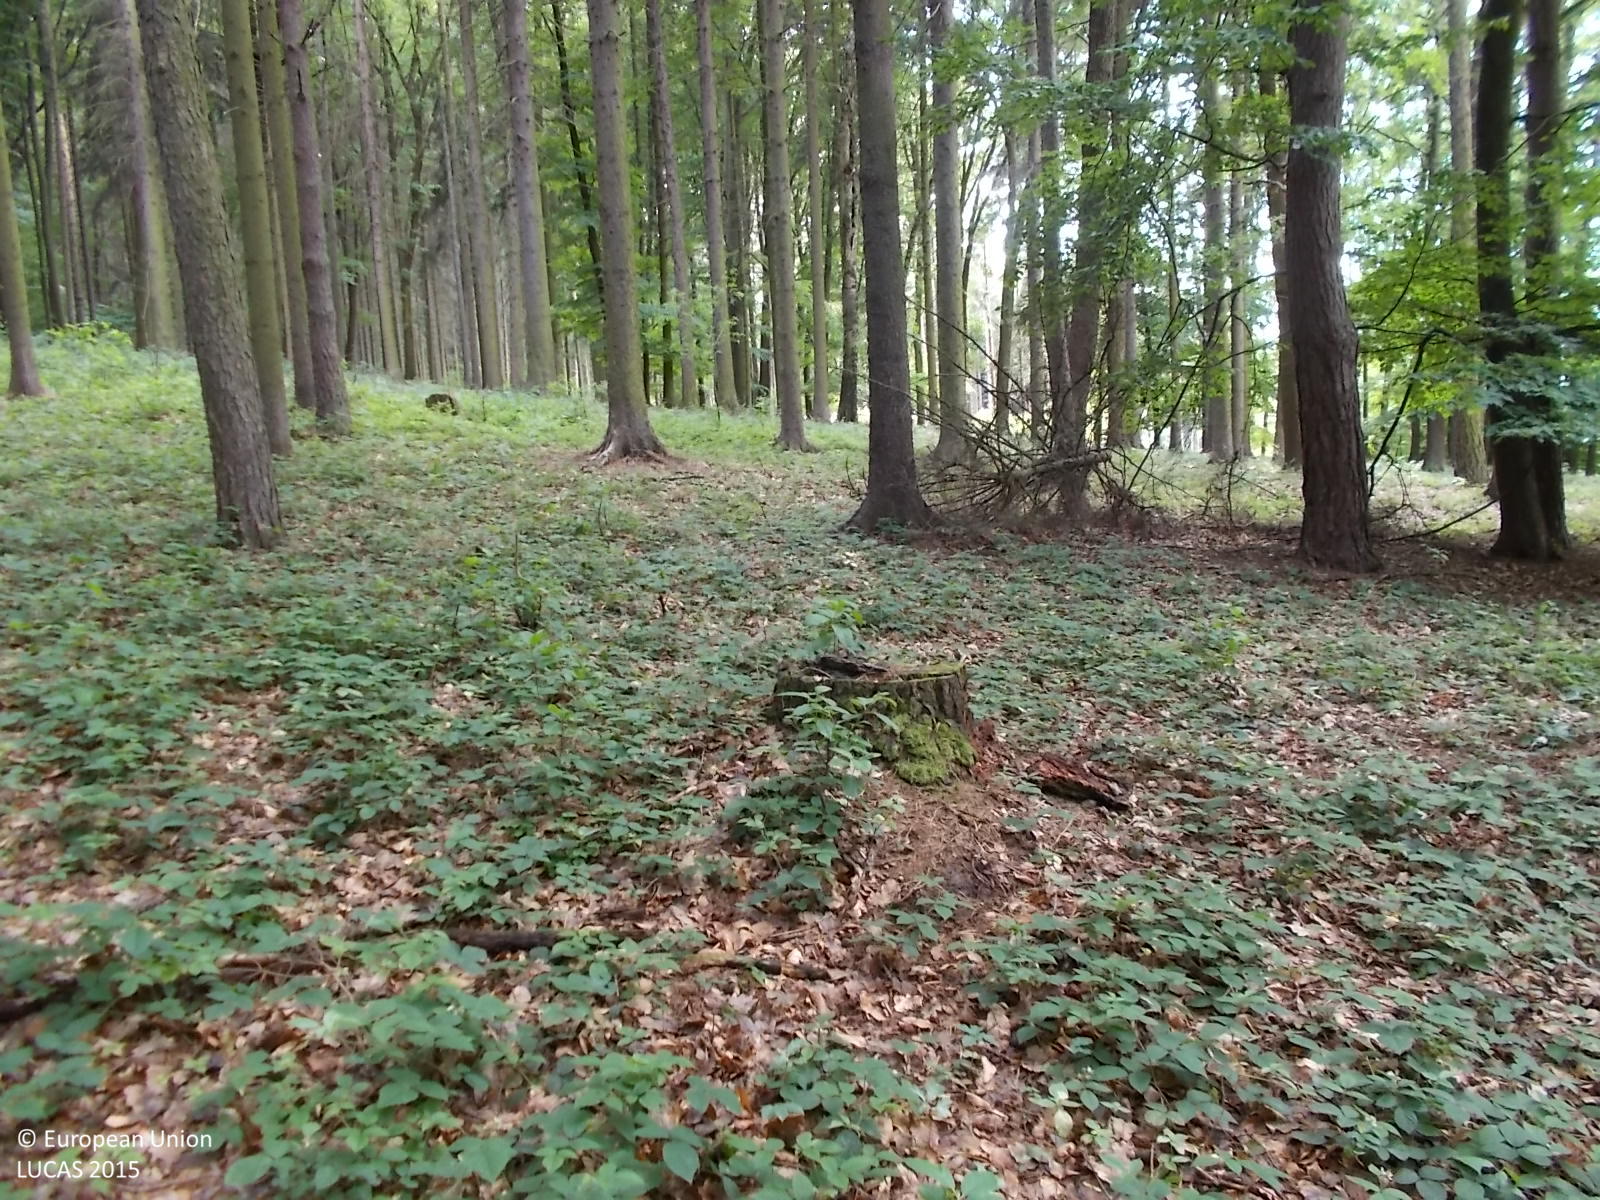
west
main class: Woodland
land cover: Other mixed woodland
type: hemiboreal forest and nemoral coniferous forest and mixed broadleaved-coniferous forest
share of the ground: > 75 %
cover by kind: coniferous forest trees 50 %, broadleaved forest trees 35 %, herbaceous plants 10 %, shrubs 5 %
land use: Forestry
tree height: > 5 m
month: June
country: CZ
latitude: 49.2631
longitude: 17.5839
